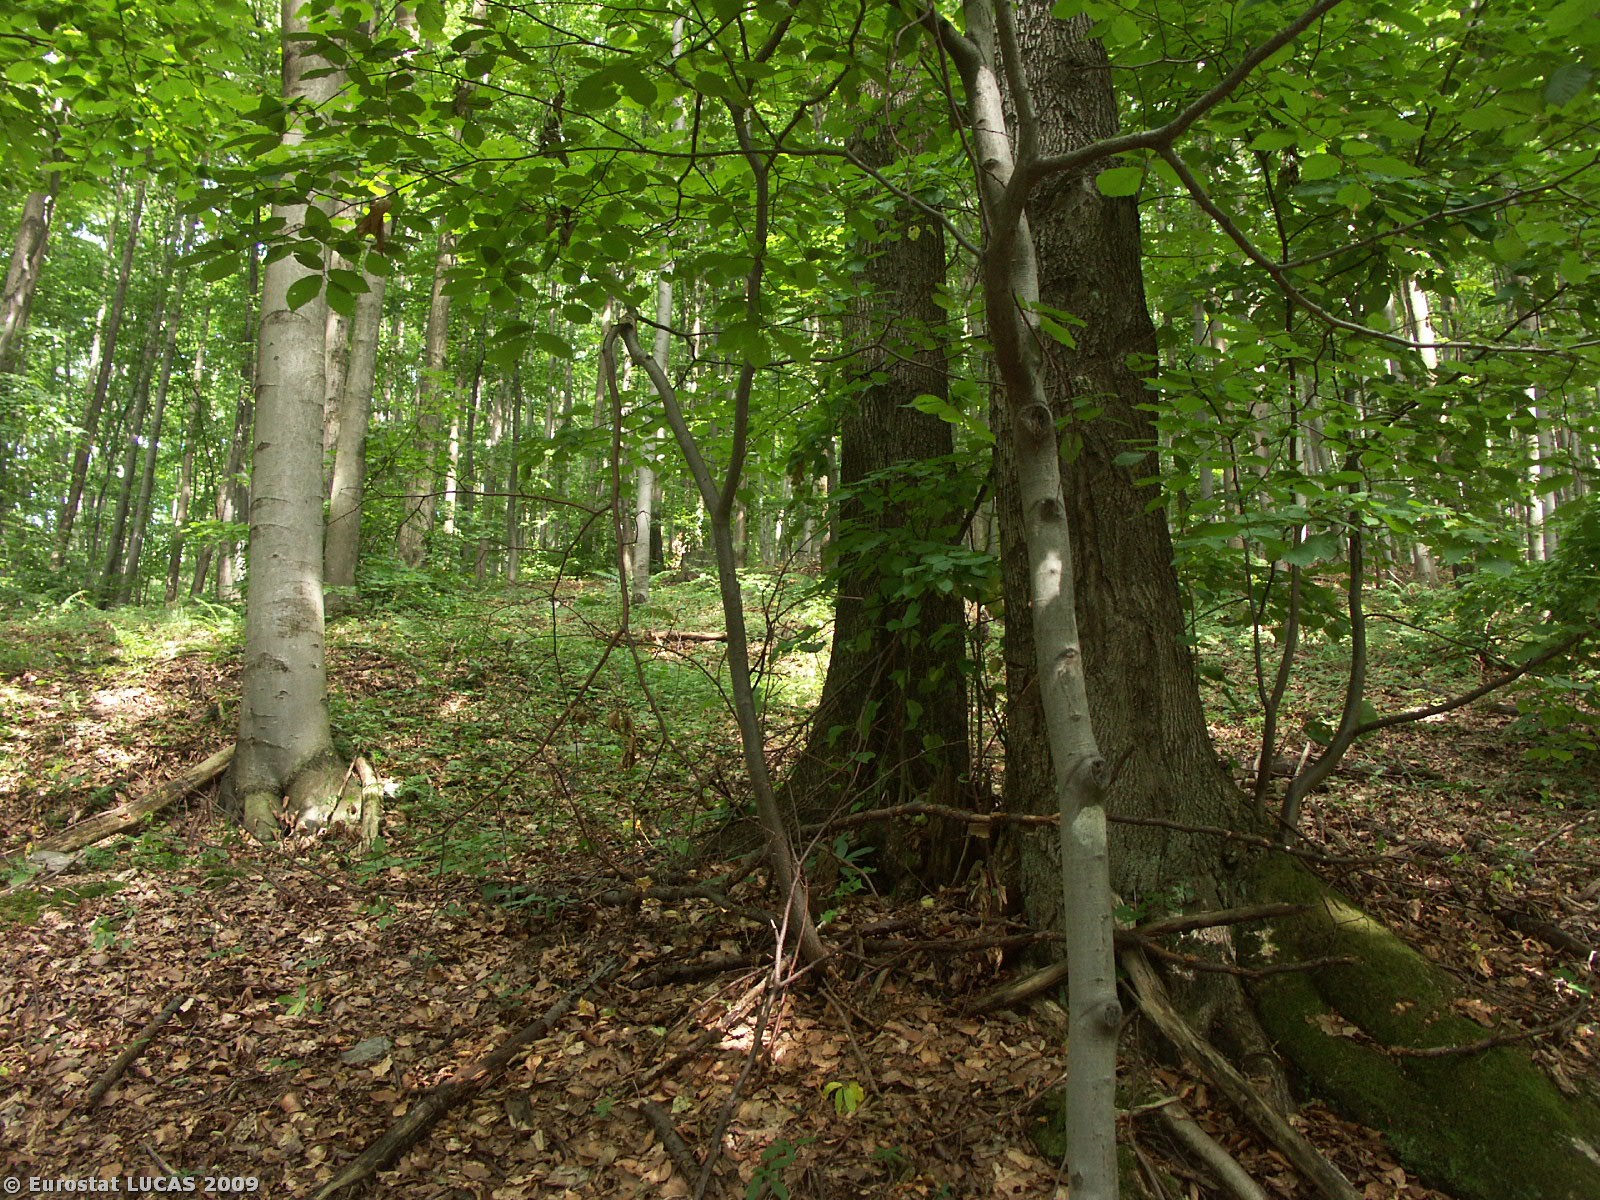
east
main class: Woodland
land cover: Broadleaved woodland
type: beech forest
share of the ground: > 75 %
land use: Forestry
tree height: > 5 m
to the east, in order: Broadleaved woodland; Tracks; Broadleaved woodland; Tracks; Broadleaved woodland; Mixed woodland
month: July
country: CZ
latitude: 49.8464
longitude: 17.2284
